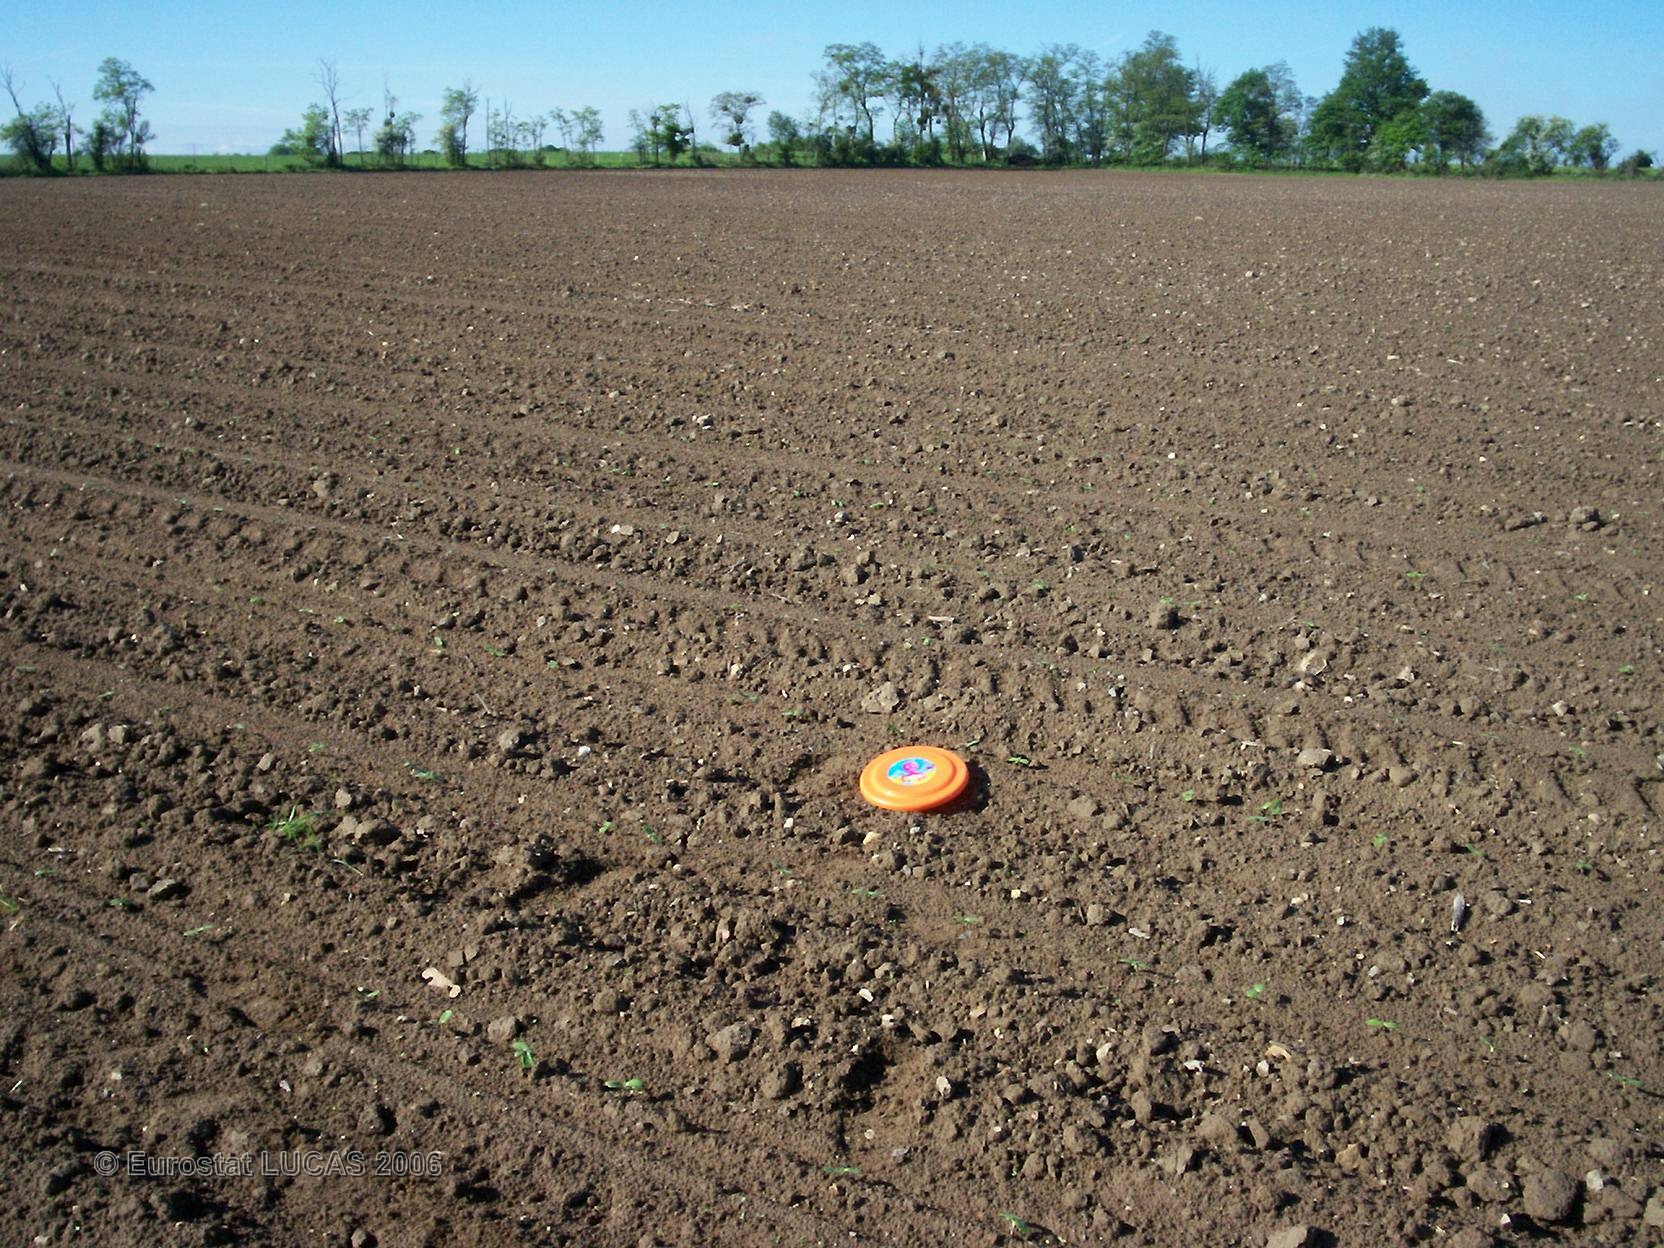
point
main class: Cropland
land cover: Sunflower
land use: Agriculture (excluding fallow land and kitchen gardens)
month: May
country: FR
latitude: 46.2672
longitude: 0.4465
